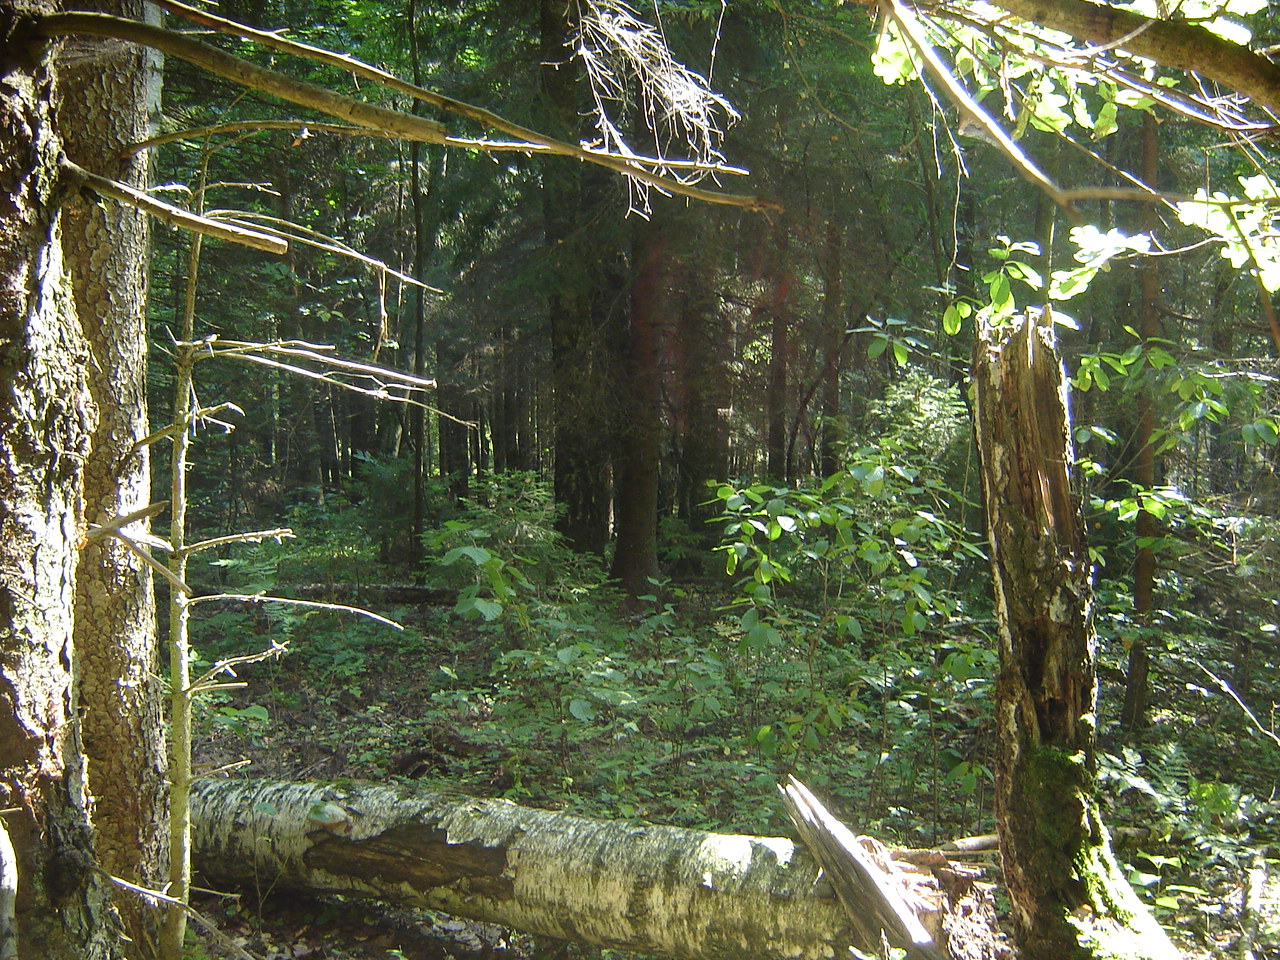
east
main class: Woodland
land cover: Other mixed woodland
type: hemiboreal forest and nemoral coniferous forest and mixed broadleaved-coniferous forest
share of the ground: > 75 %
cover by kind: coniferous forest trees 50 %, broadleaved forest trees 40 %, herbaceous plants 5 %, unconsolidated bare surface 5 %
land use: Forestry
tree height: > 5 m
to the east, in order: Other mixed woodland; Other coniferous woodland
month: August
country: LT
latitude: 55.0840
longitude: 25.1080
